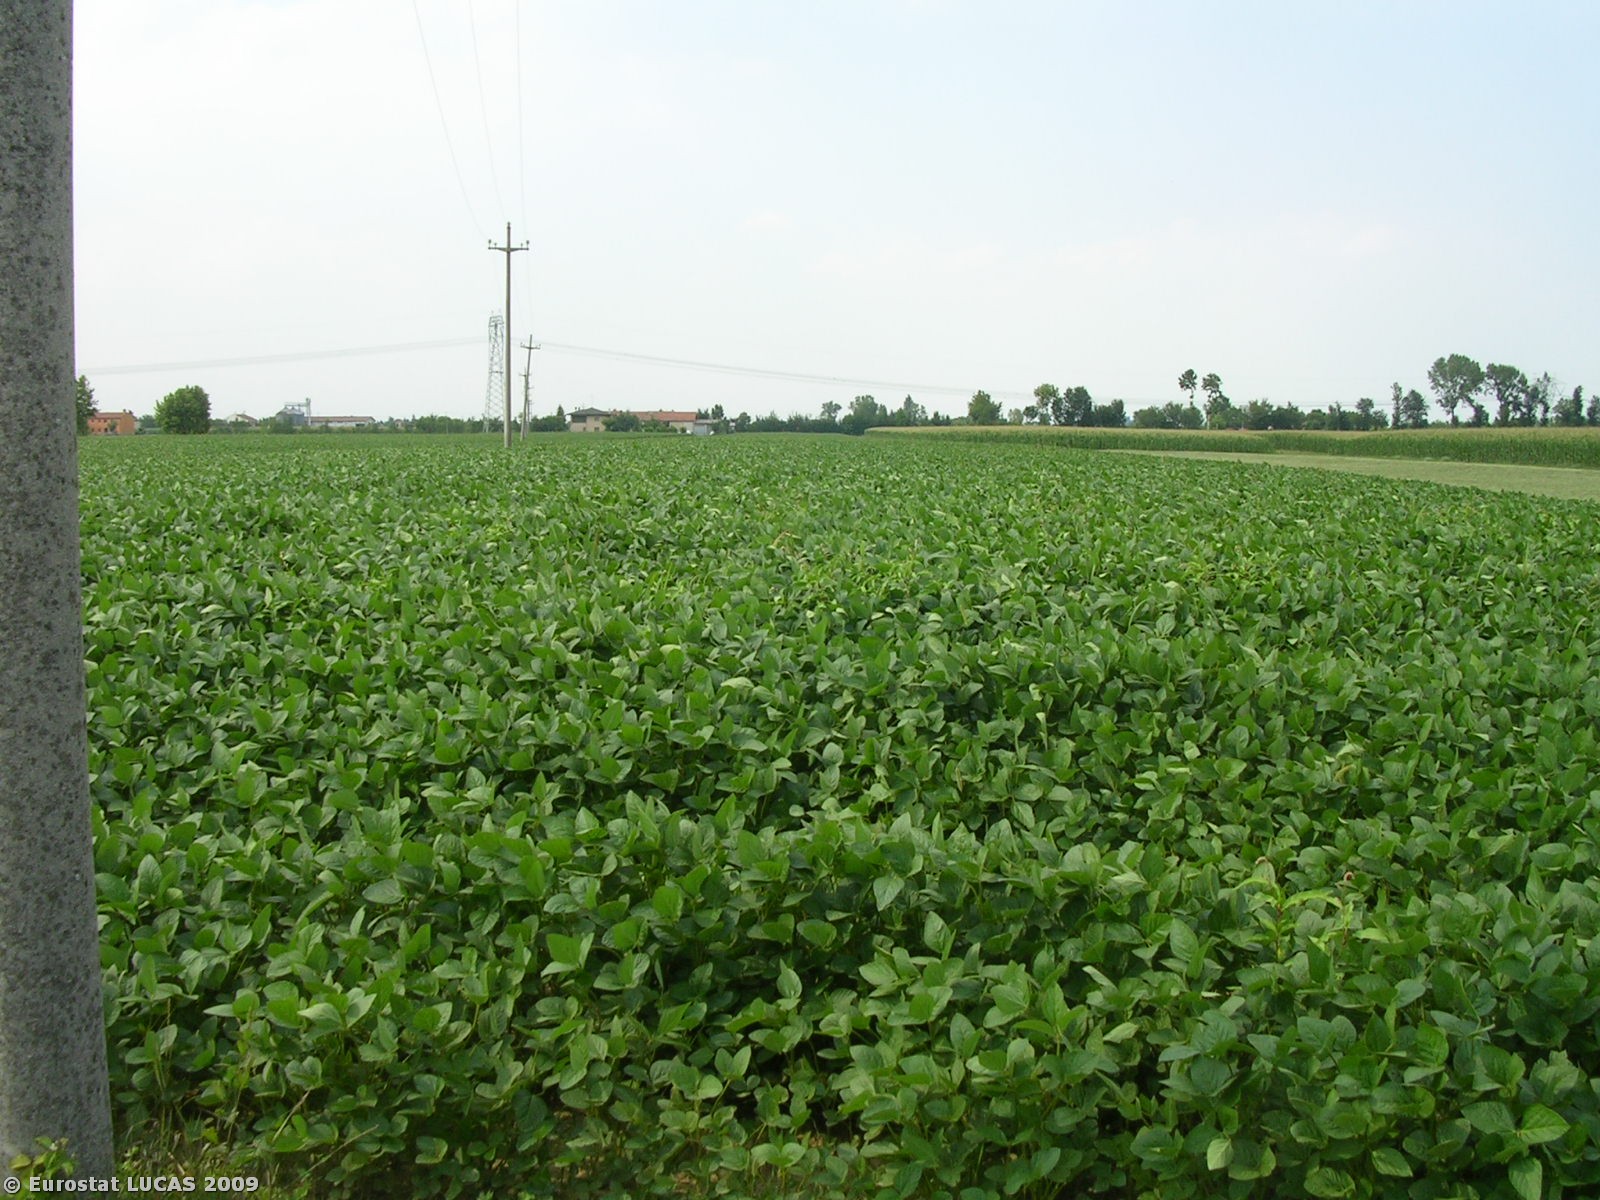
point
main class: Cropland
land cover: Soya
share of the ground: > 75 %
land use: Agriculture (excluding fallow land and kitchen gardens)
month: July
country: IT
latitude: 45.4011
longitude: 11.6708
